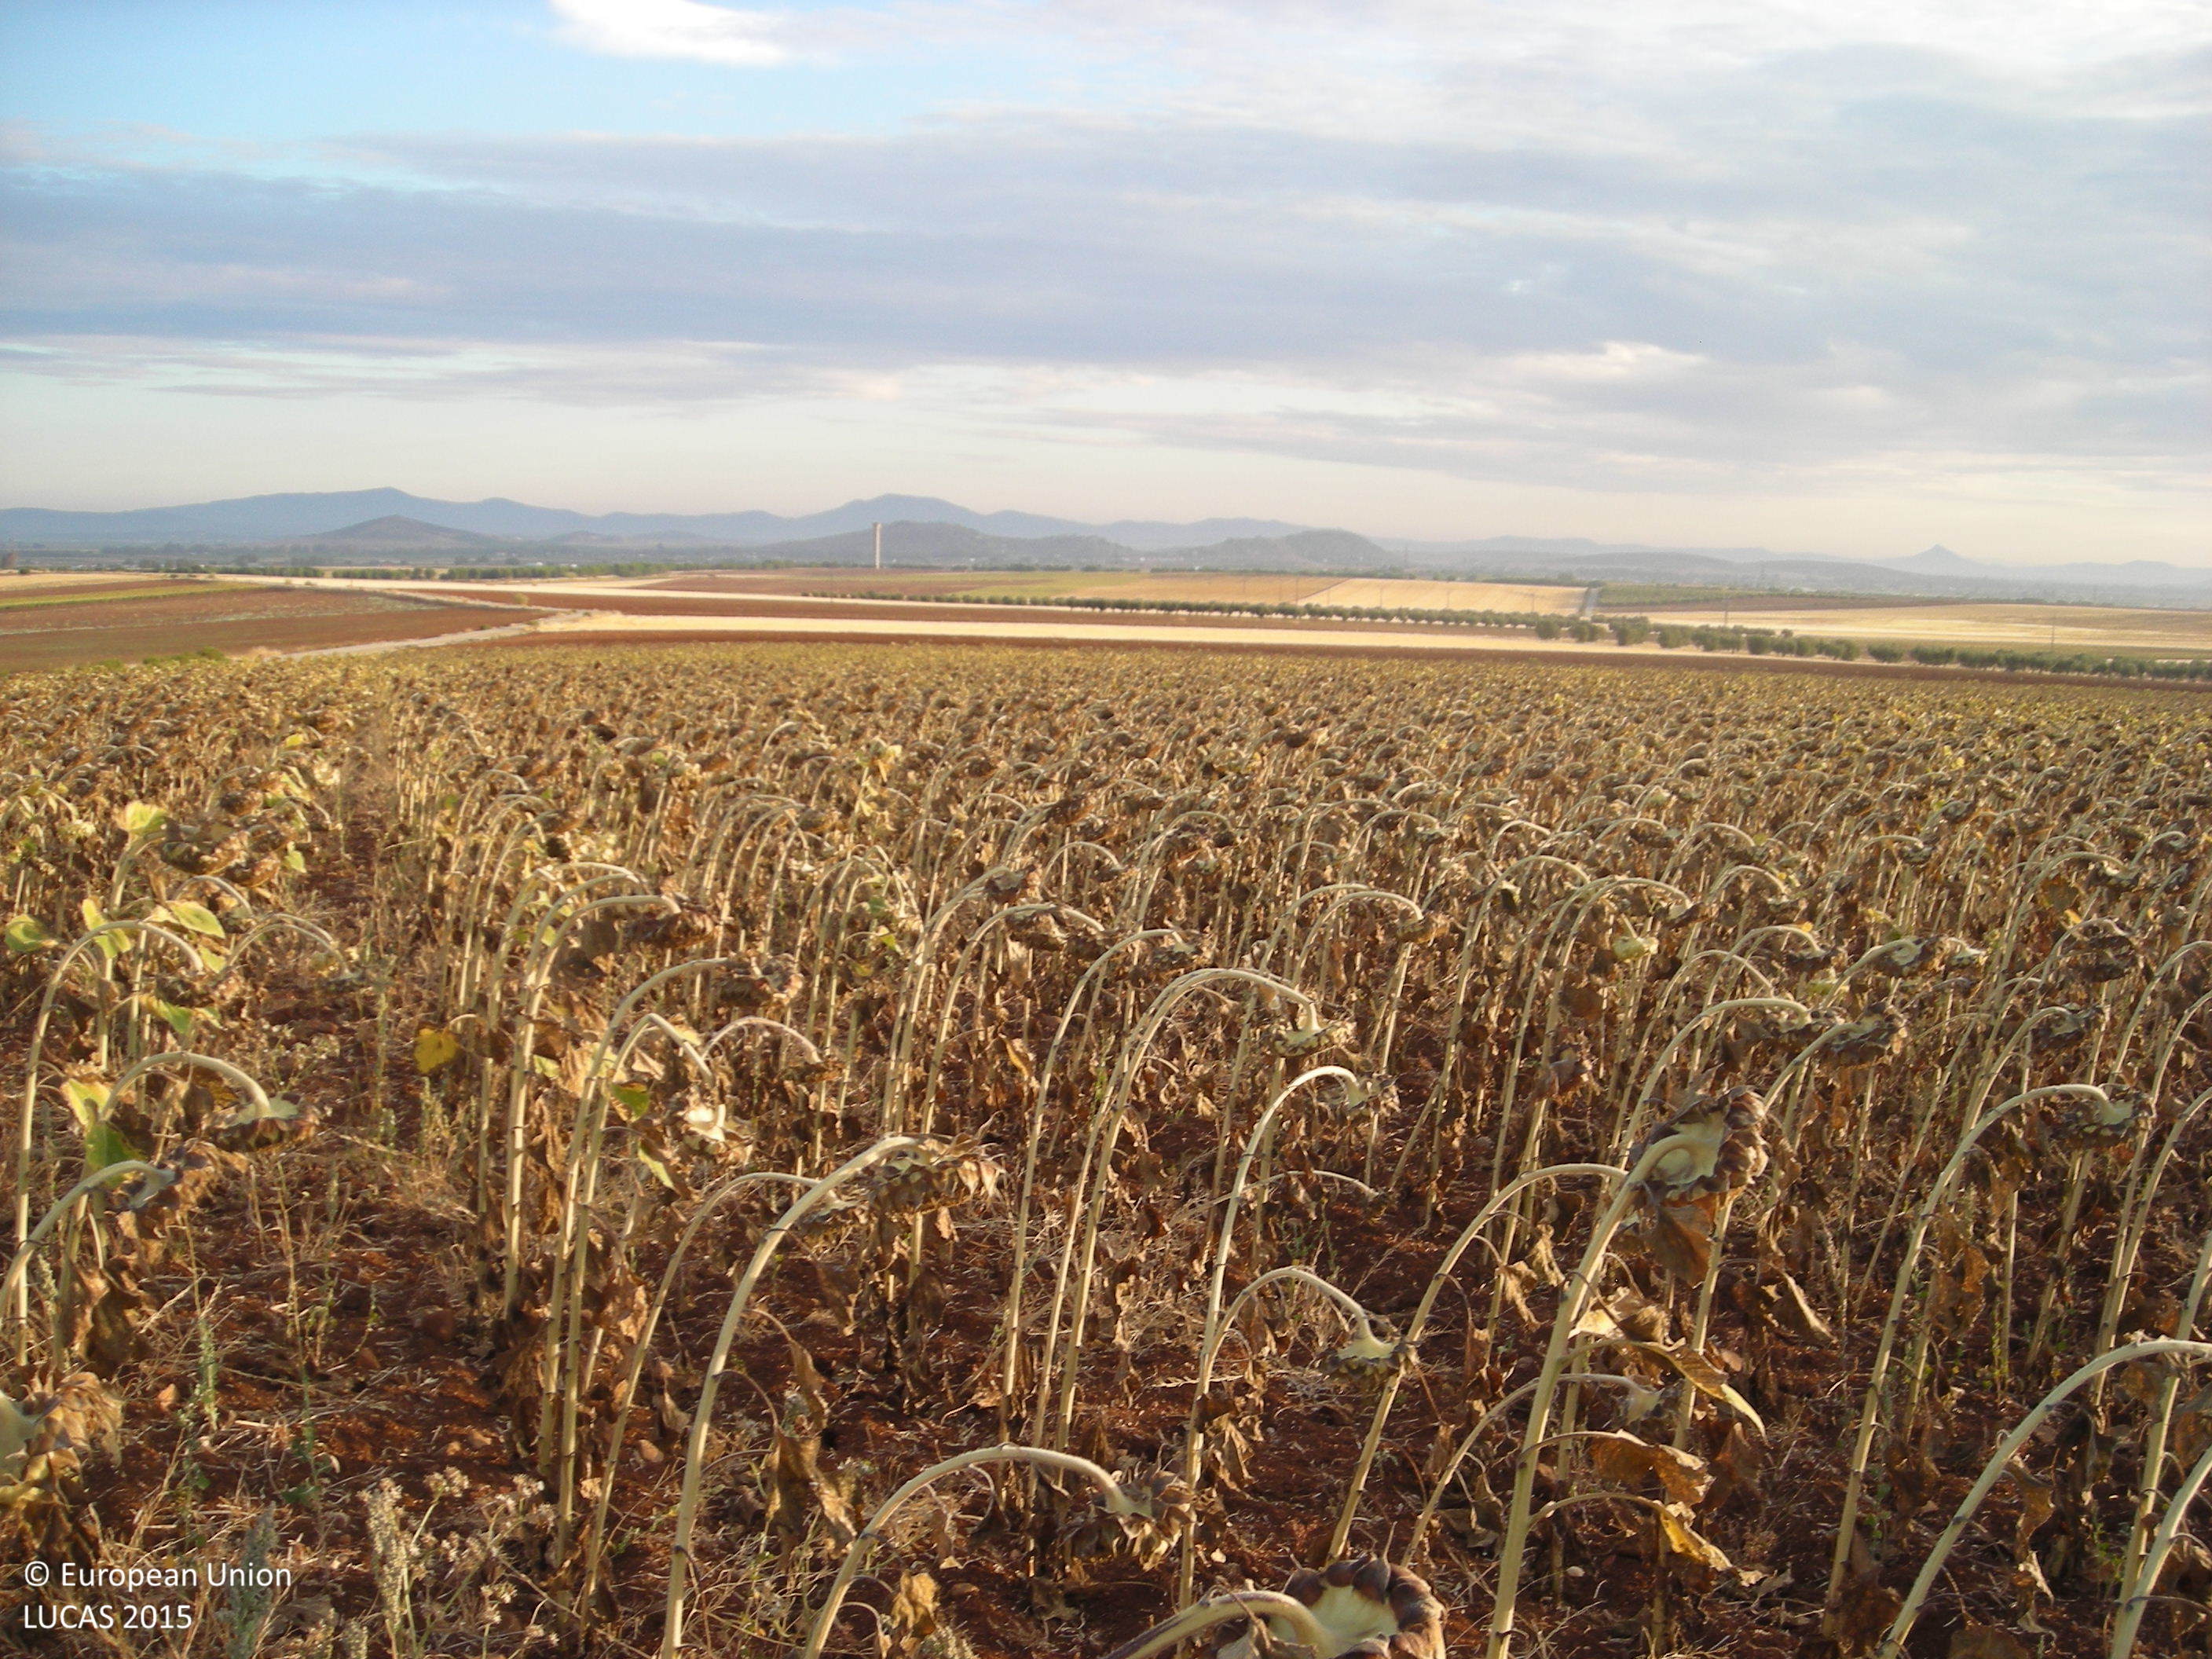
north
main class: Cropland
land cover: Sunflower
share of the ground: > 75 %
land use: Agriculture (excluding fallow land and kitchen gardens)
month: July
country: ES
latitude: 38.8978
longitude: -5.9500
